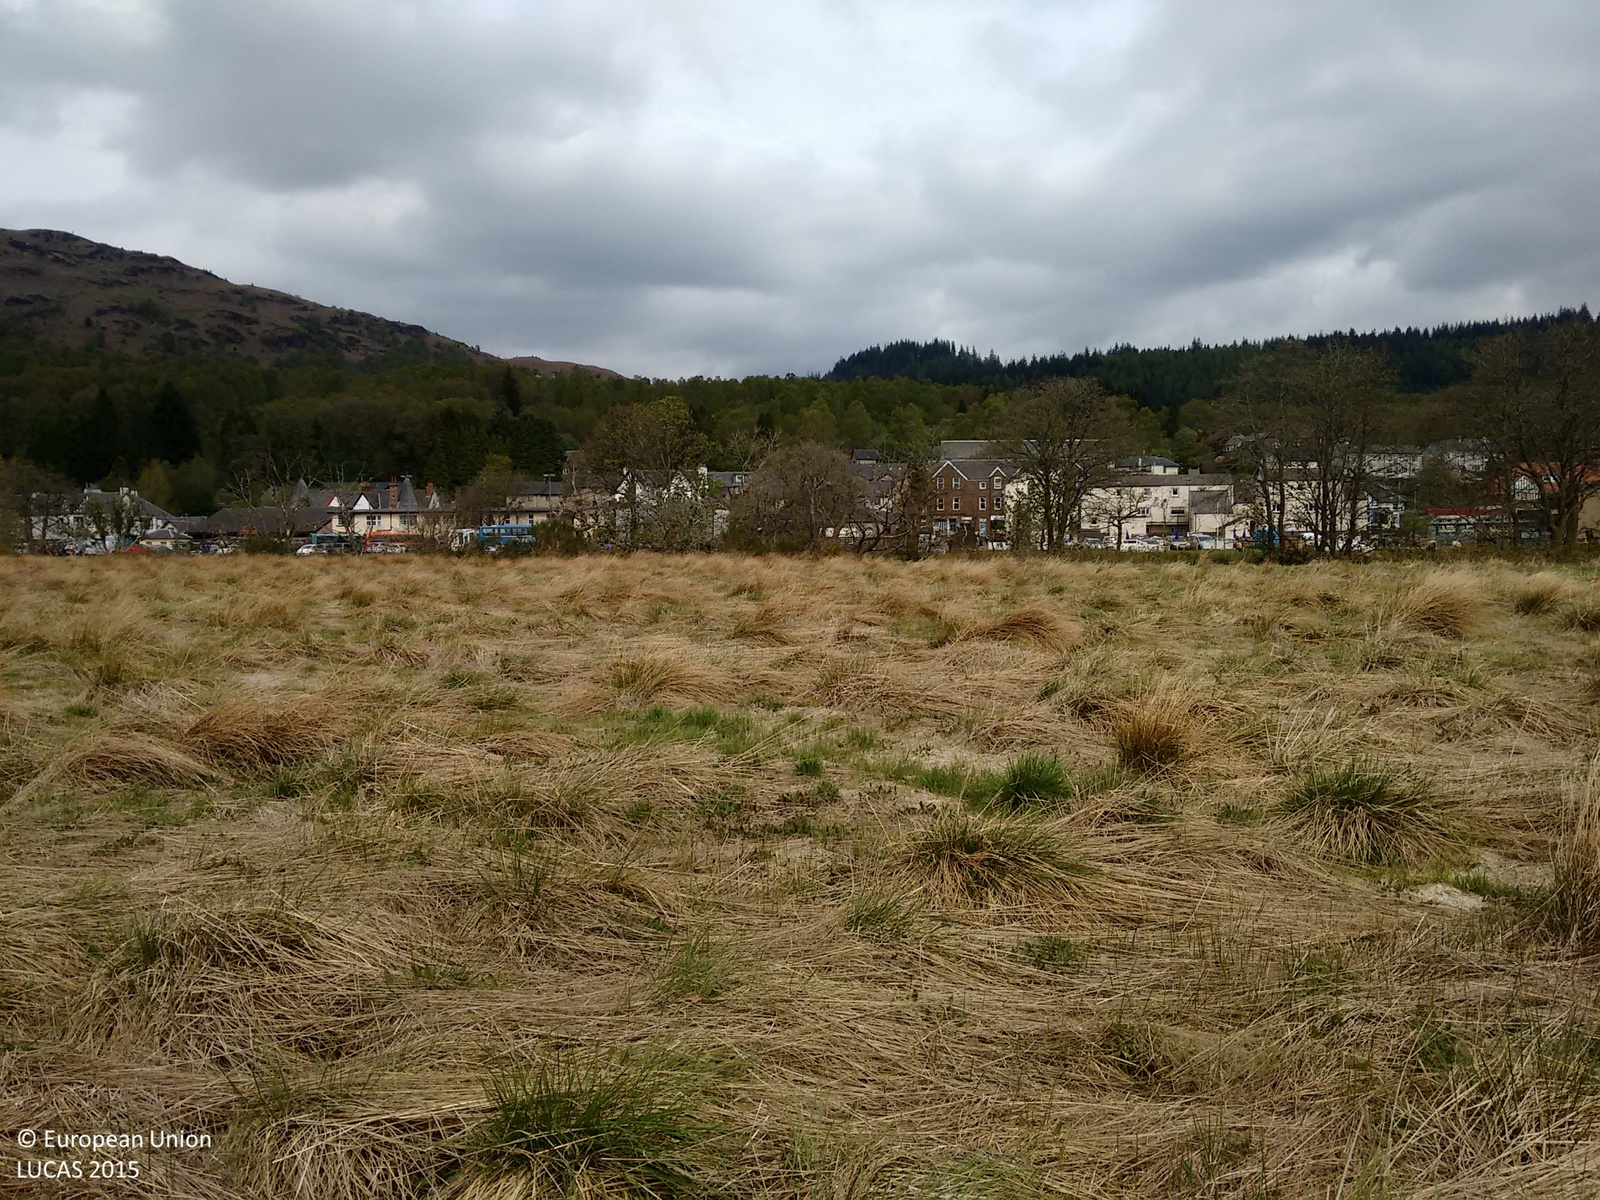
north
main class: Grassland
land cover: Grassland without tree/shrub cover
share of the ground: > 75 %
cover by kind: herbaceous plants 100 %
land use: Semi-natural and natural areas not in use
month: May
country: GB
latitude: 56.1767
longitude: -4.3829
